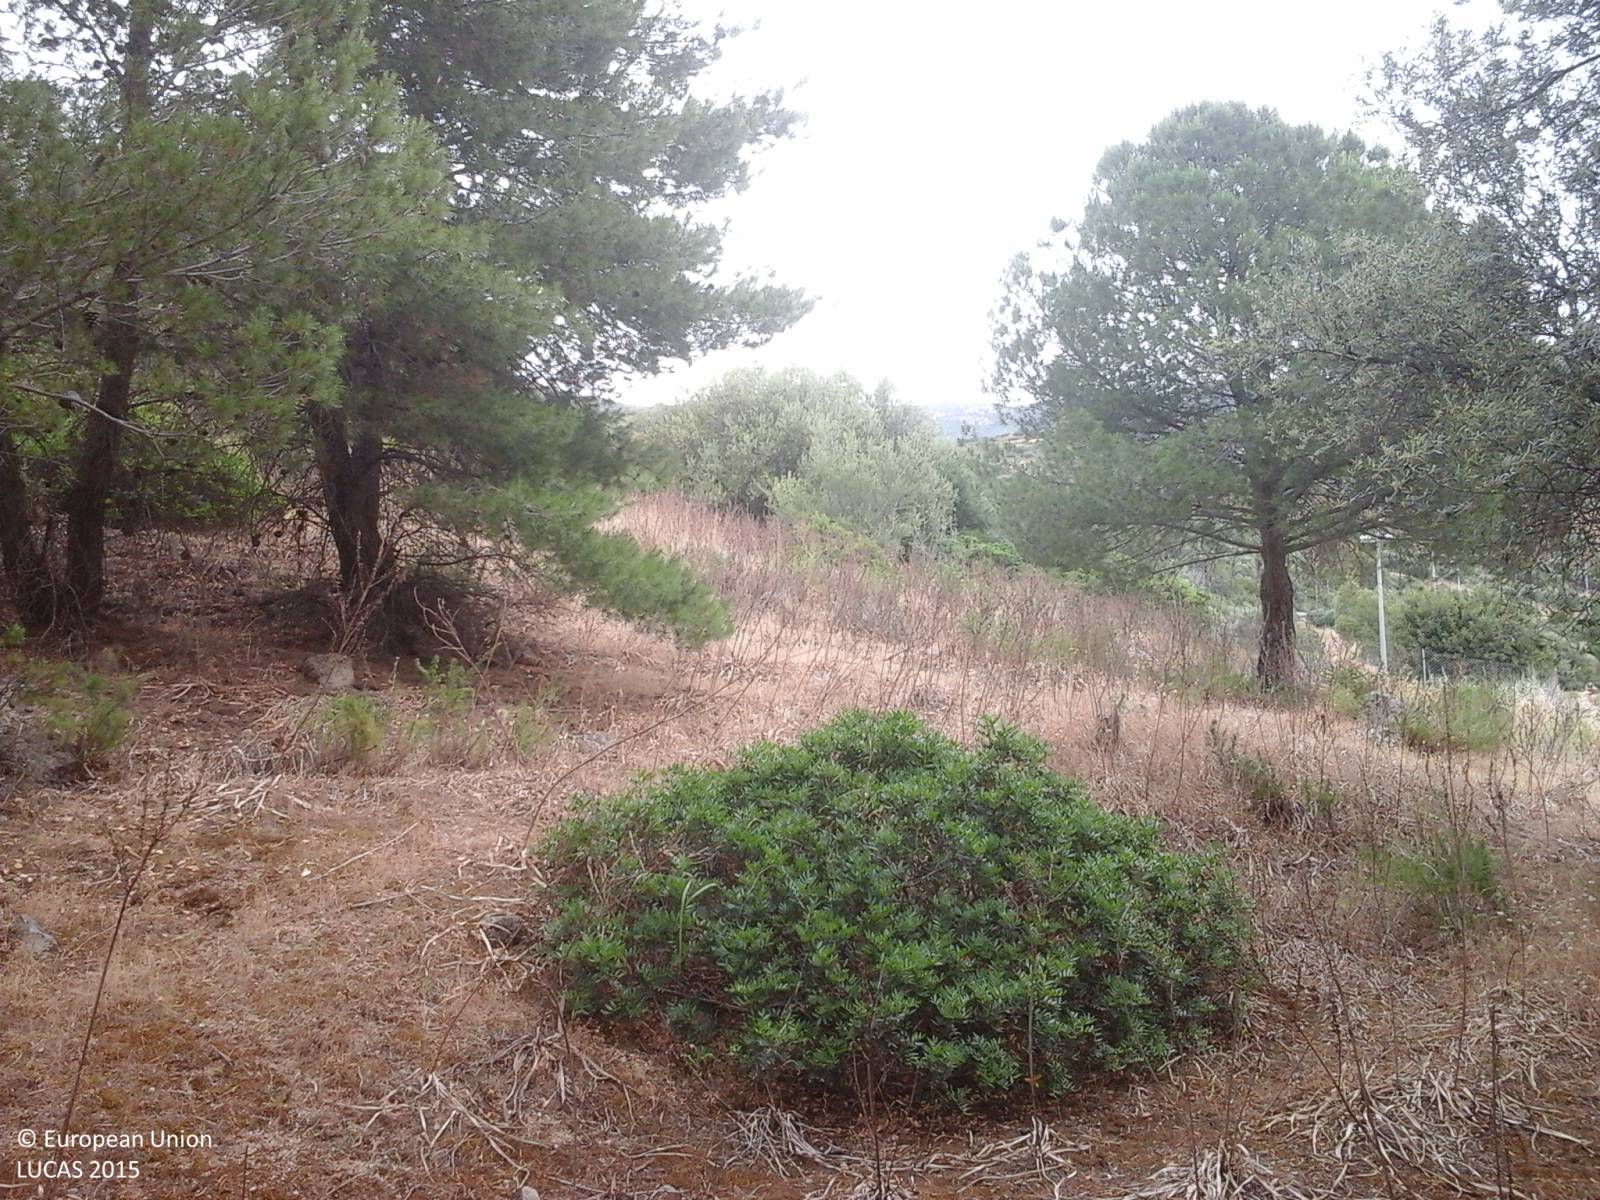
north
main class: Woodland
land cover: Pine dominated coniferous woodland
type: coniferous forest of the mediterranean region
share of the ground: > 75 %
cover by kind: coniferous forest trees 50 %, shrubs 30 %, broadleaved forest trees 10 %, herbaceous plants 10 %
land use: Semi-natural and natural areas not in use
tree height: > 5 m
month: May
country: IT
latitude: 39.1965
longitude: 9.3441
